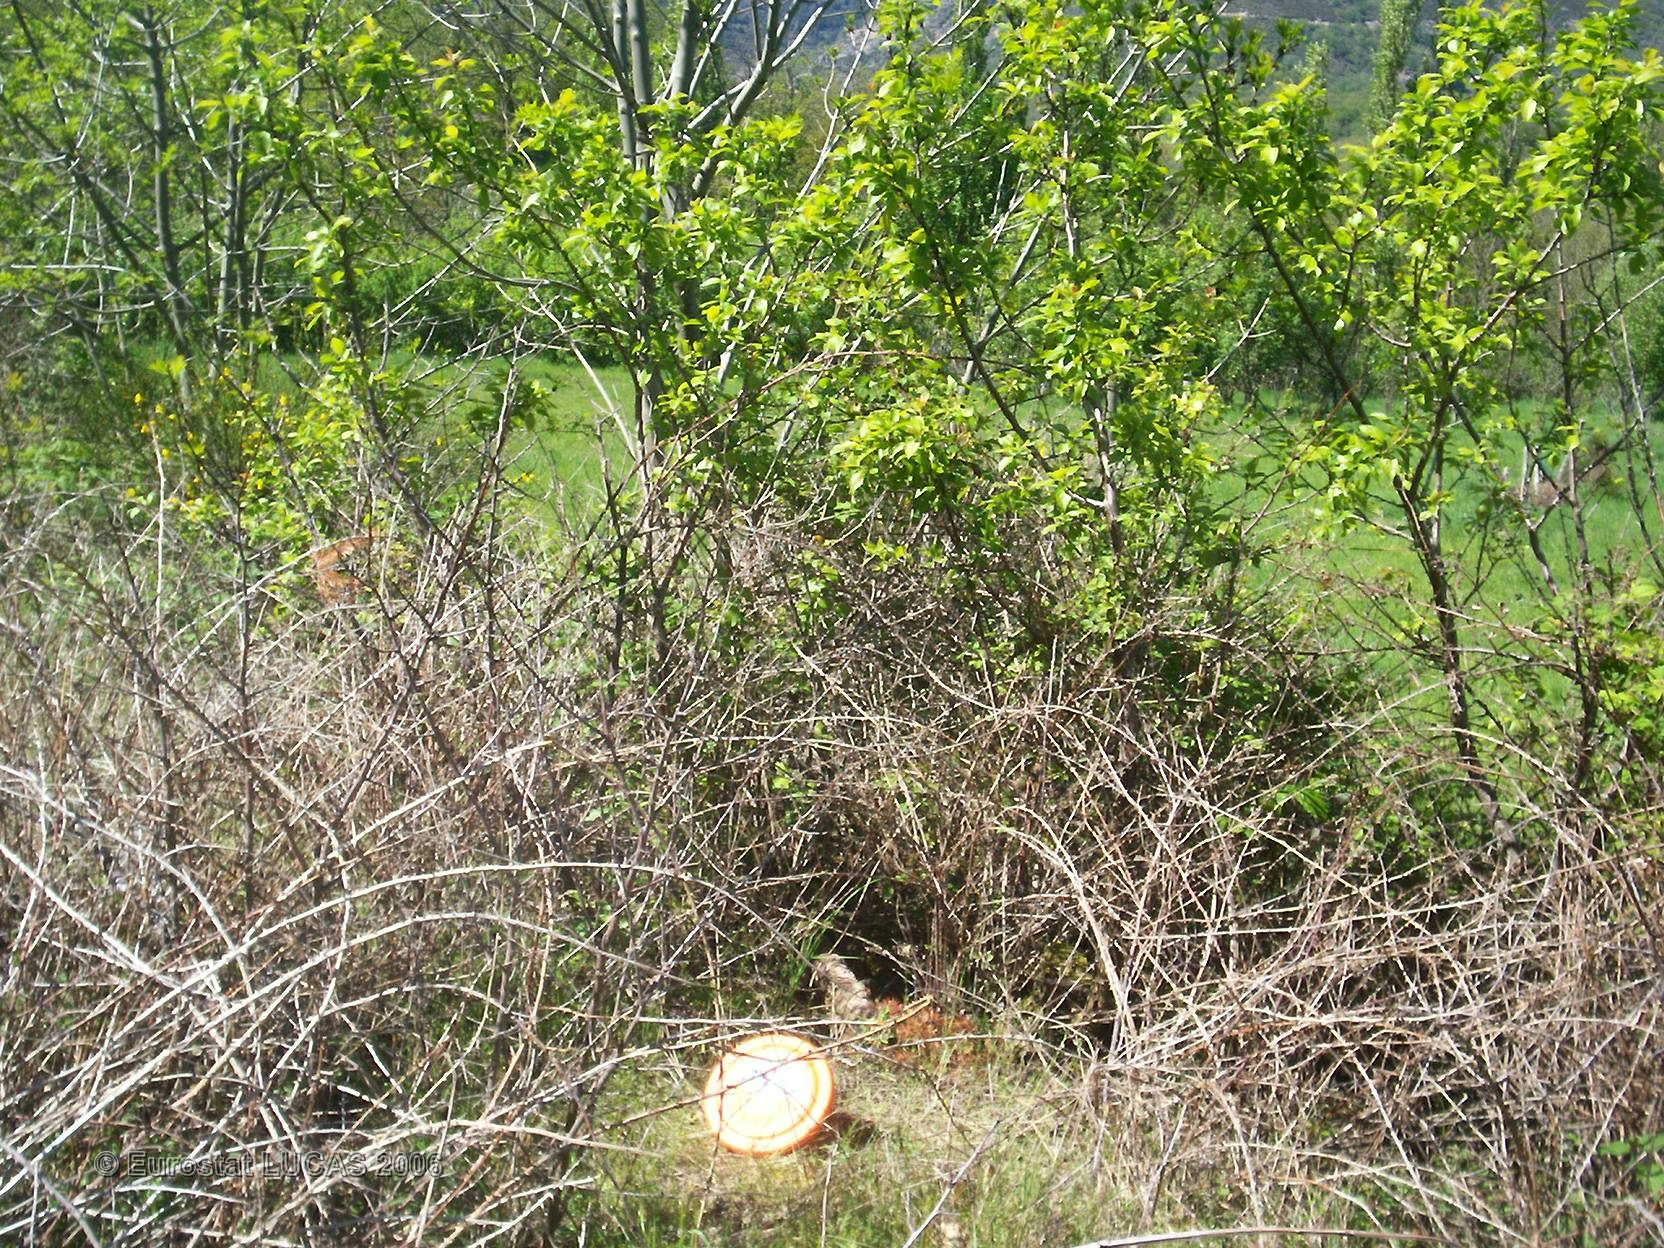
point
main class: Grassland
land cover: Grassland with sparse tree/shrub cover
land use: Unused
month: May
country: FR
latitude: 44.0517
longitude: 3.4290
